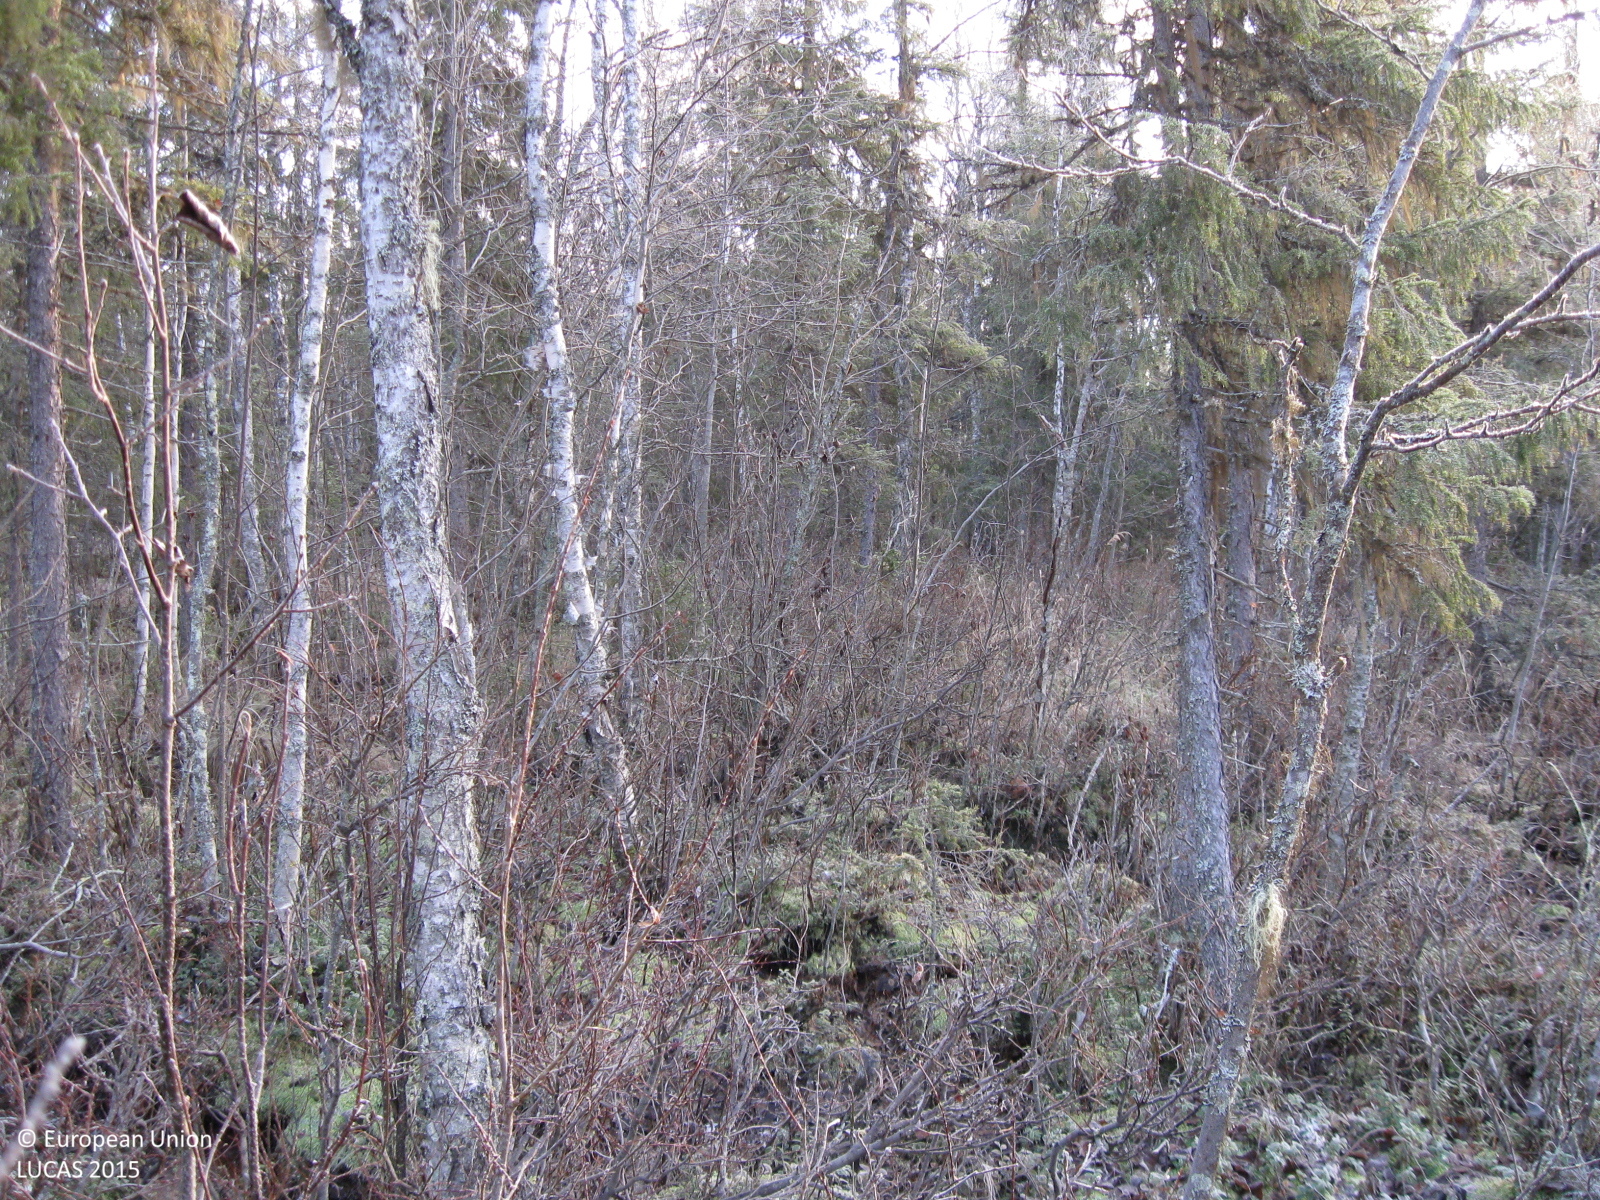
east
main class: Woodland
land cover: Spruce dominated mixed woodland
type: mire and swamp forests
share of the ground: > 75 %
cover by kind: broadleaved forest trees 50 %, coniferous forest trees 25 %, herbaceous plants 20 %, shrubs 5 %
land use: Semi-natural and natural areas not in use
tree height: > 5 m
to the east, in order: Spruce dominated mixed woodland; Spruce dominated coniferous woodland; Ditches and canals; Spruce dominated coniferous woodland
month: October
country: SE
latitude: 66.0968
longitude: 21.5796
